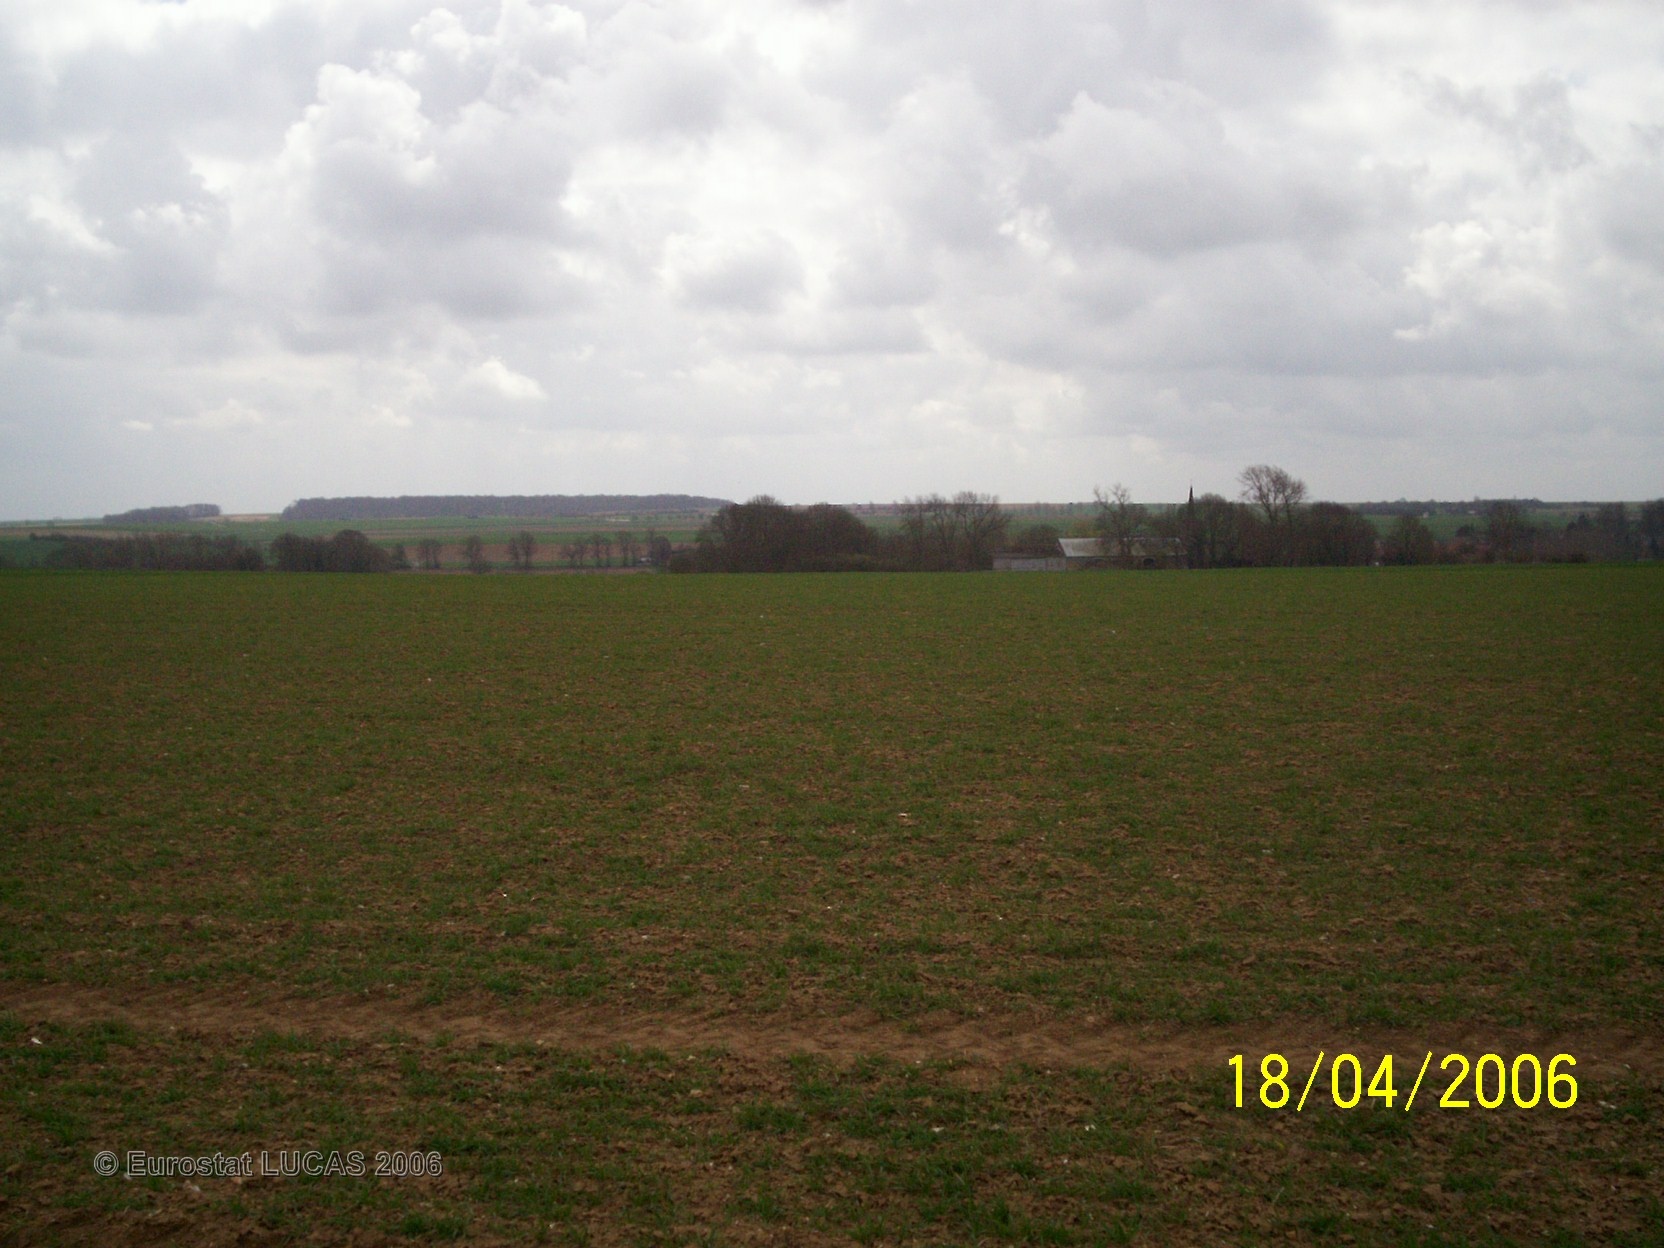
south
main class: Cropland
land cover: Common wheat
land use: Agriculture (excluding fallow land and kitchen gardens)
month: April
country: FR
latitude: 50.3595
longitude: 2.6083
